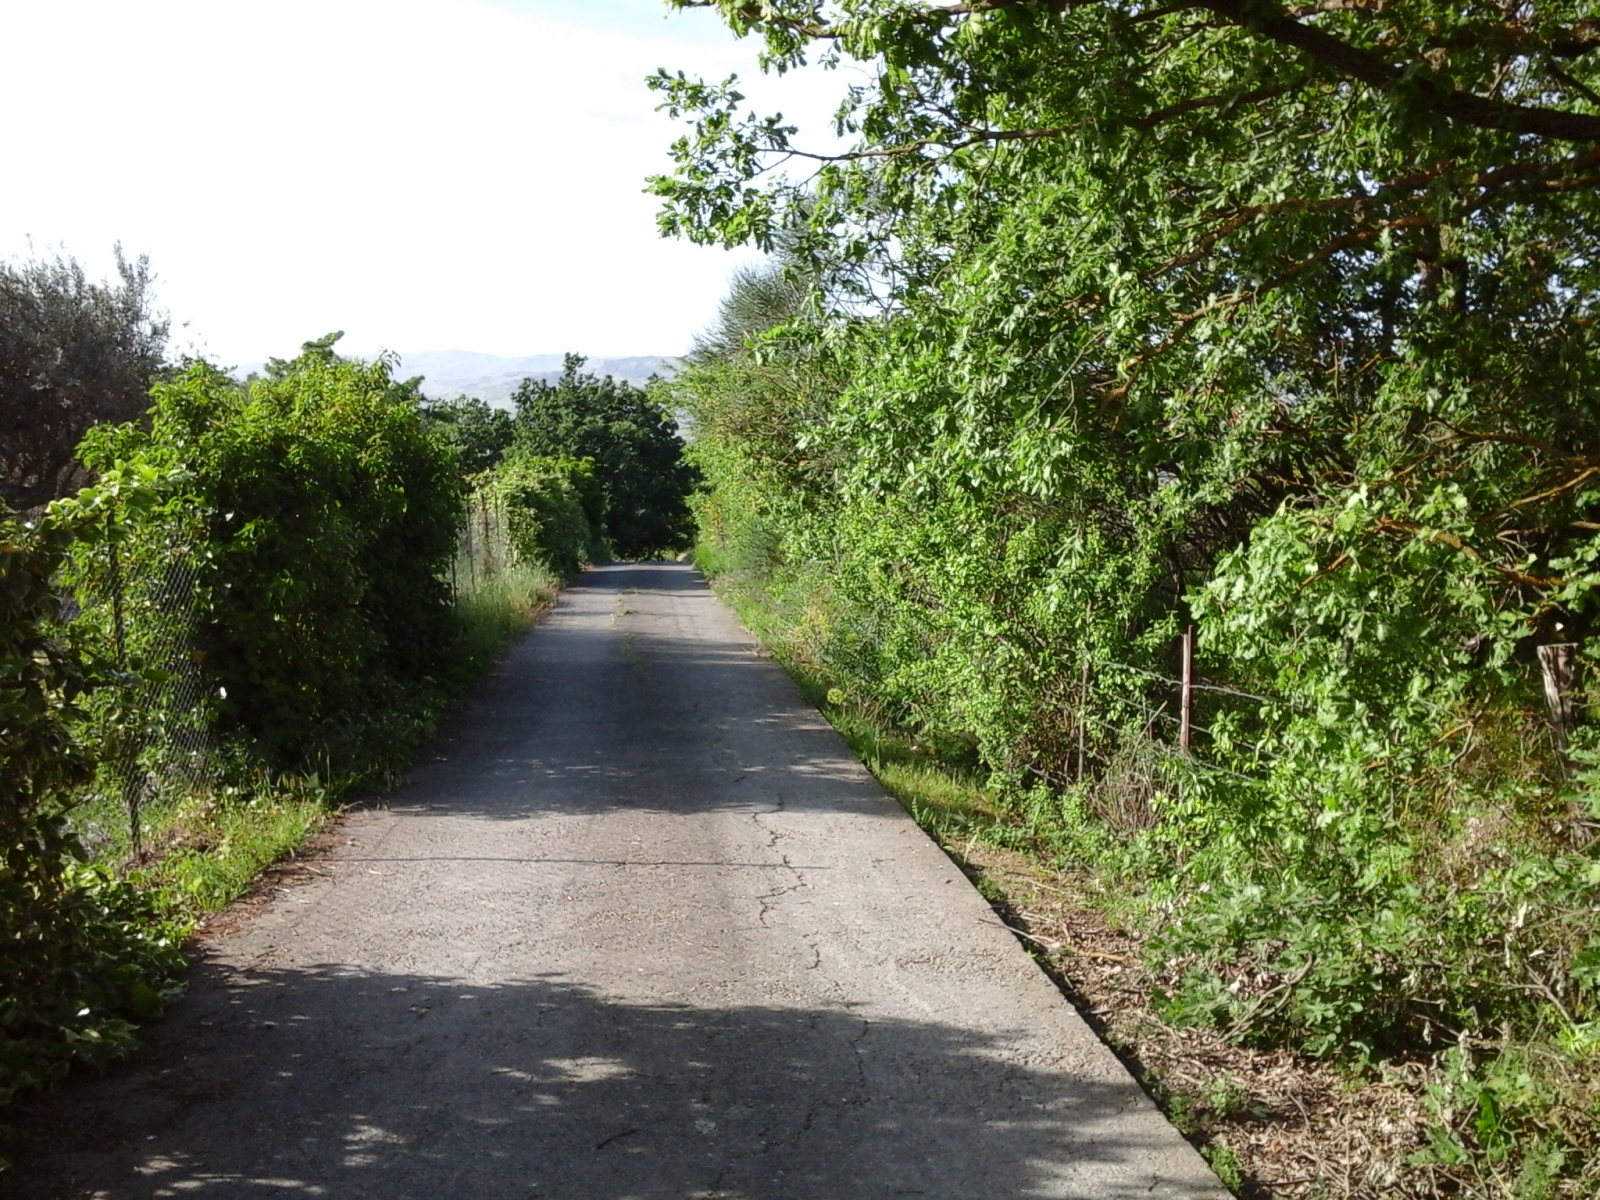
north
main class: Woodland
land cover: Broadleaved woodland
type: broadleaved evergreen forest
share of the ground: > 75 %
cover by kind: broadleaved forest trees 70 %, shrubs 20 %, coniferous forest trees 10 %
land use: Forestry
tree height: > 5 m
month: May
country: IT
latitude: 37.4985
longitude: 14.0306
